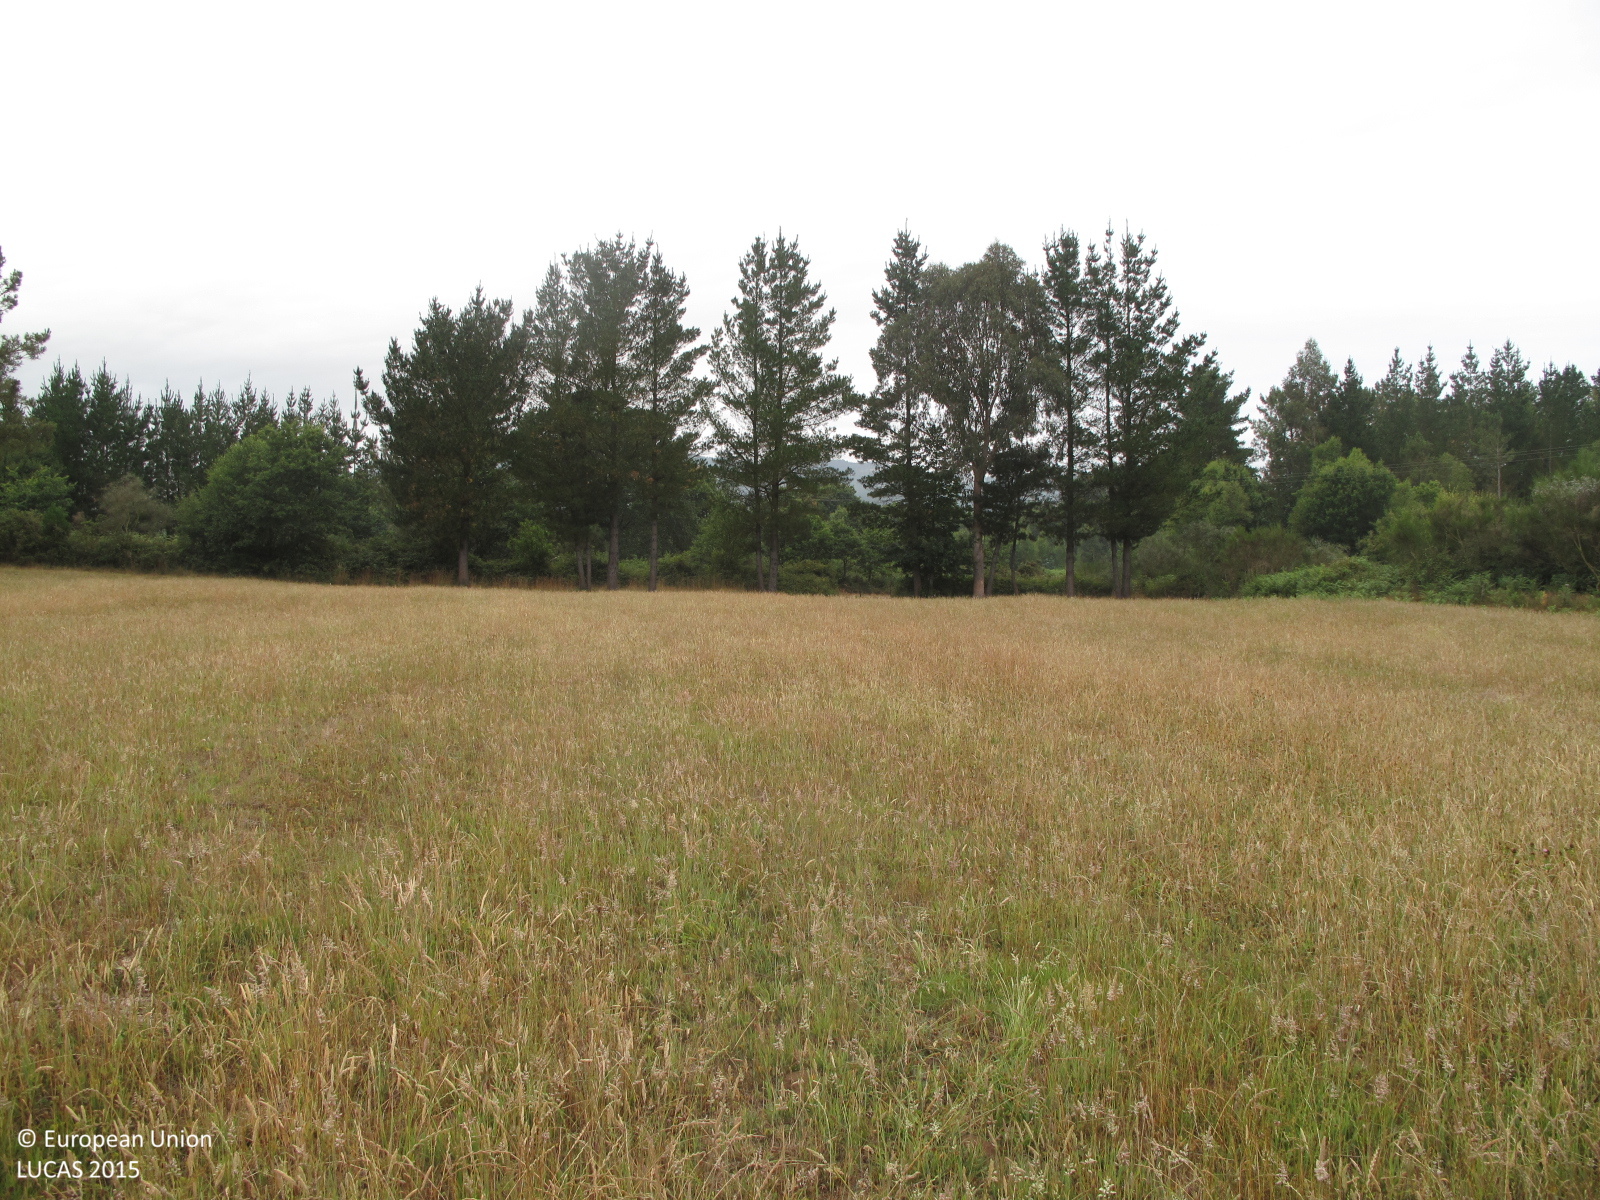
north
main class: Grassland
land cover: Grassland without tree/shrub cover
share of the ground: > 75 %
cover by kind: herbaceous plants 100 %
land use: Agriculture (excluding fallow land and kitchen gardens)
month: July
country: ES
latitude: 43.1769
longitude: -7.9406
